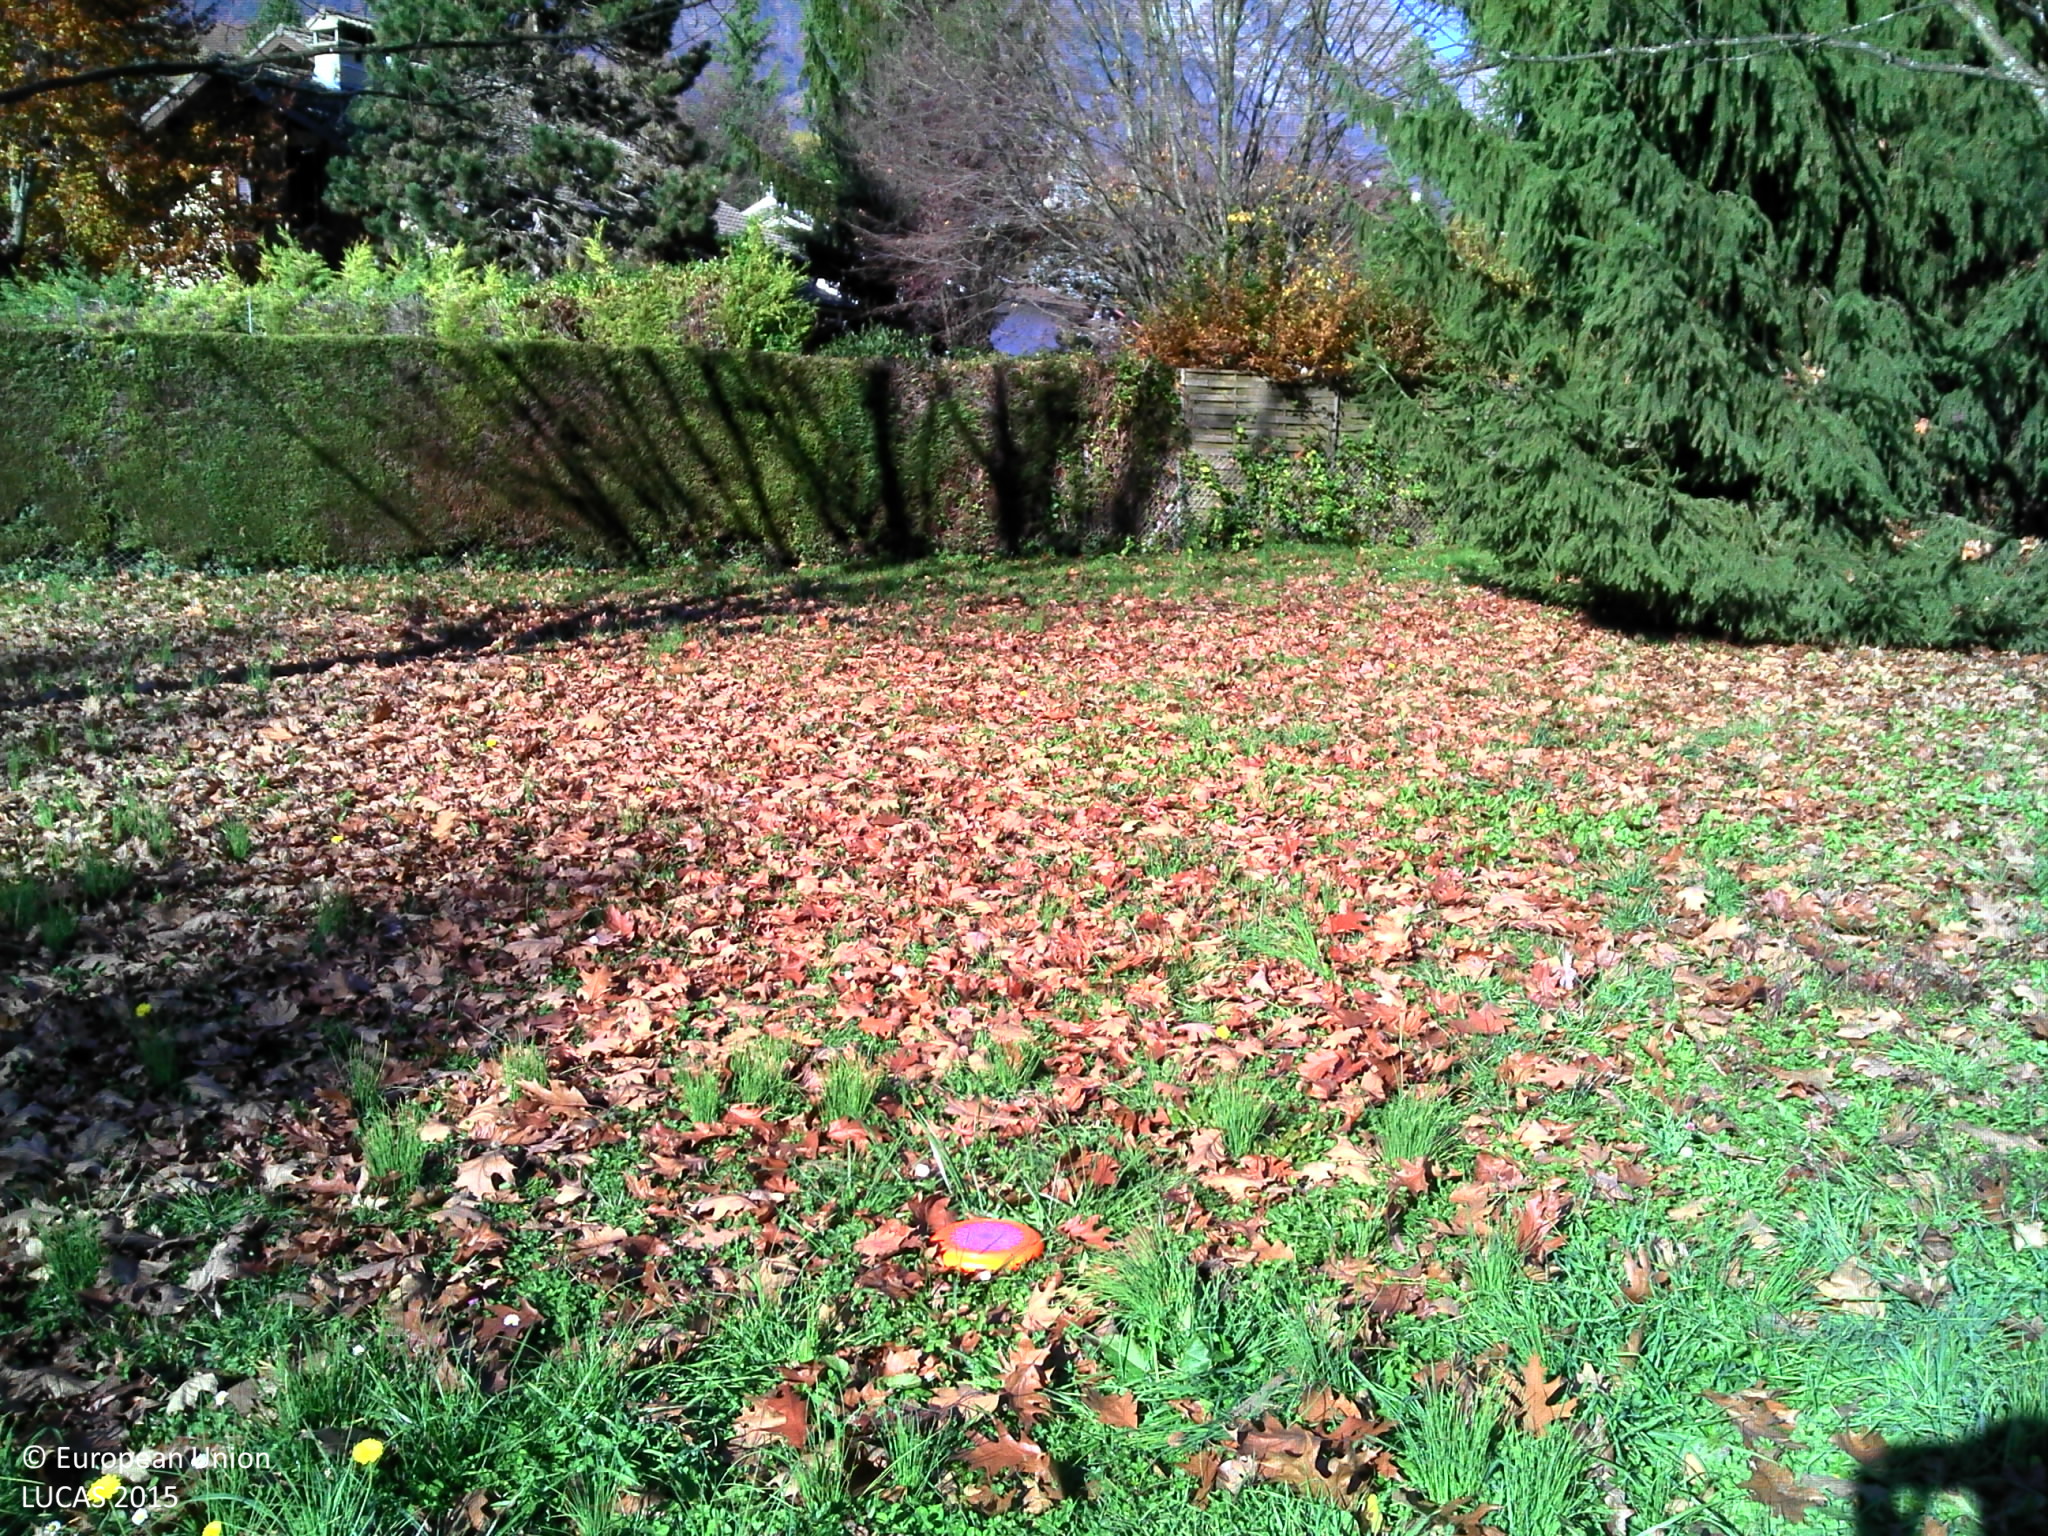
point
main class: Grassland
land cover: Grassland with sparse tree/shrub cover
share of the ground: > 75 %
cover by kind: herbaceous plants 95 %, broadleaved forest trees 5 %
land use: Amenities, museums, leisure
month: November
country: FR
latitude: 45.6577
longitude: 6.3468
